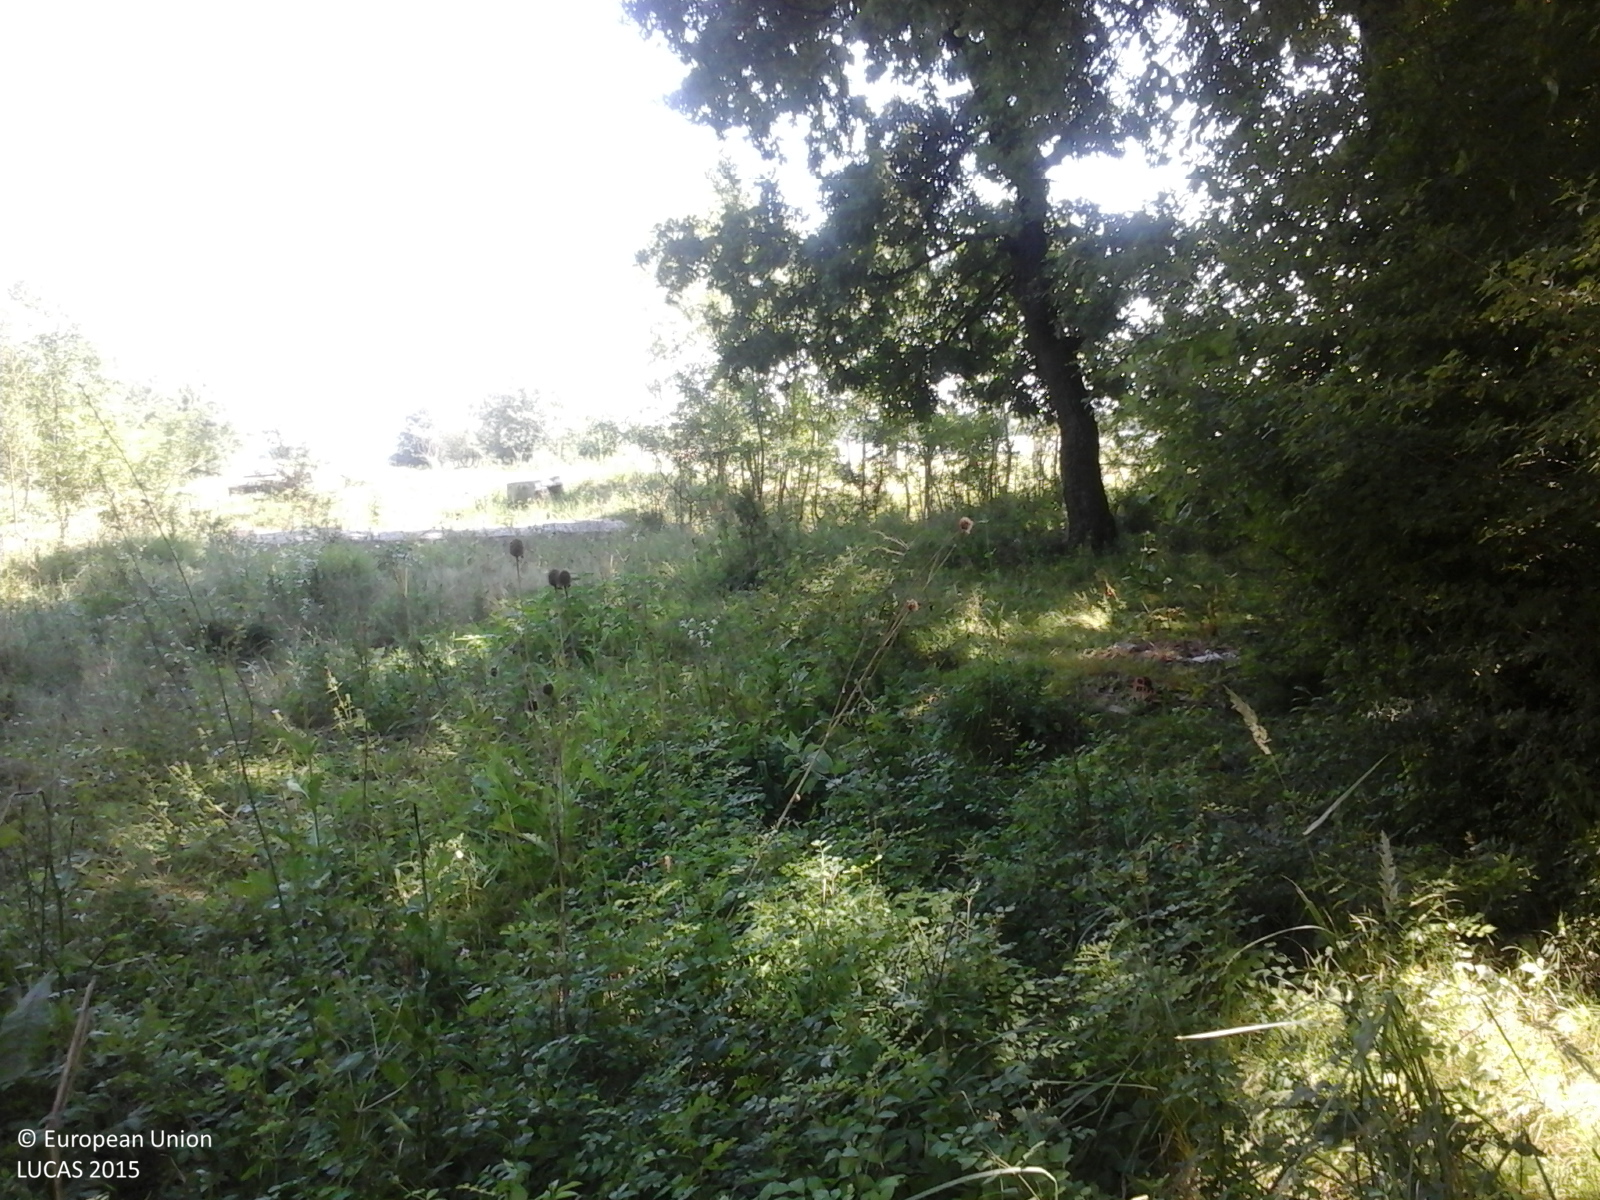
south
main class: Grassland
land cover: Spontaneously vegetated surfaces
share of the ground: > 75 %
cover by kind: herbaceous plants 100 %
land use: Fallow land
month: July
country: RO
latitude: 44.1659
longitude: 24.5124
